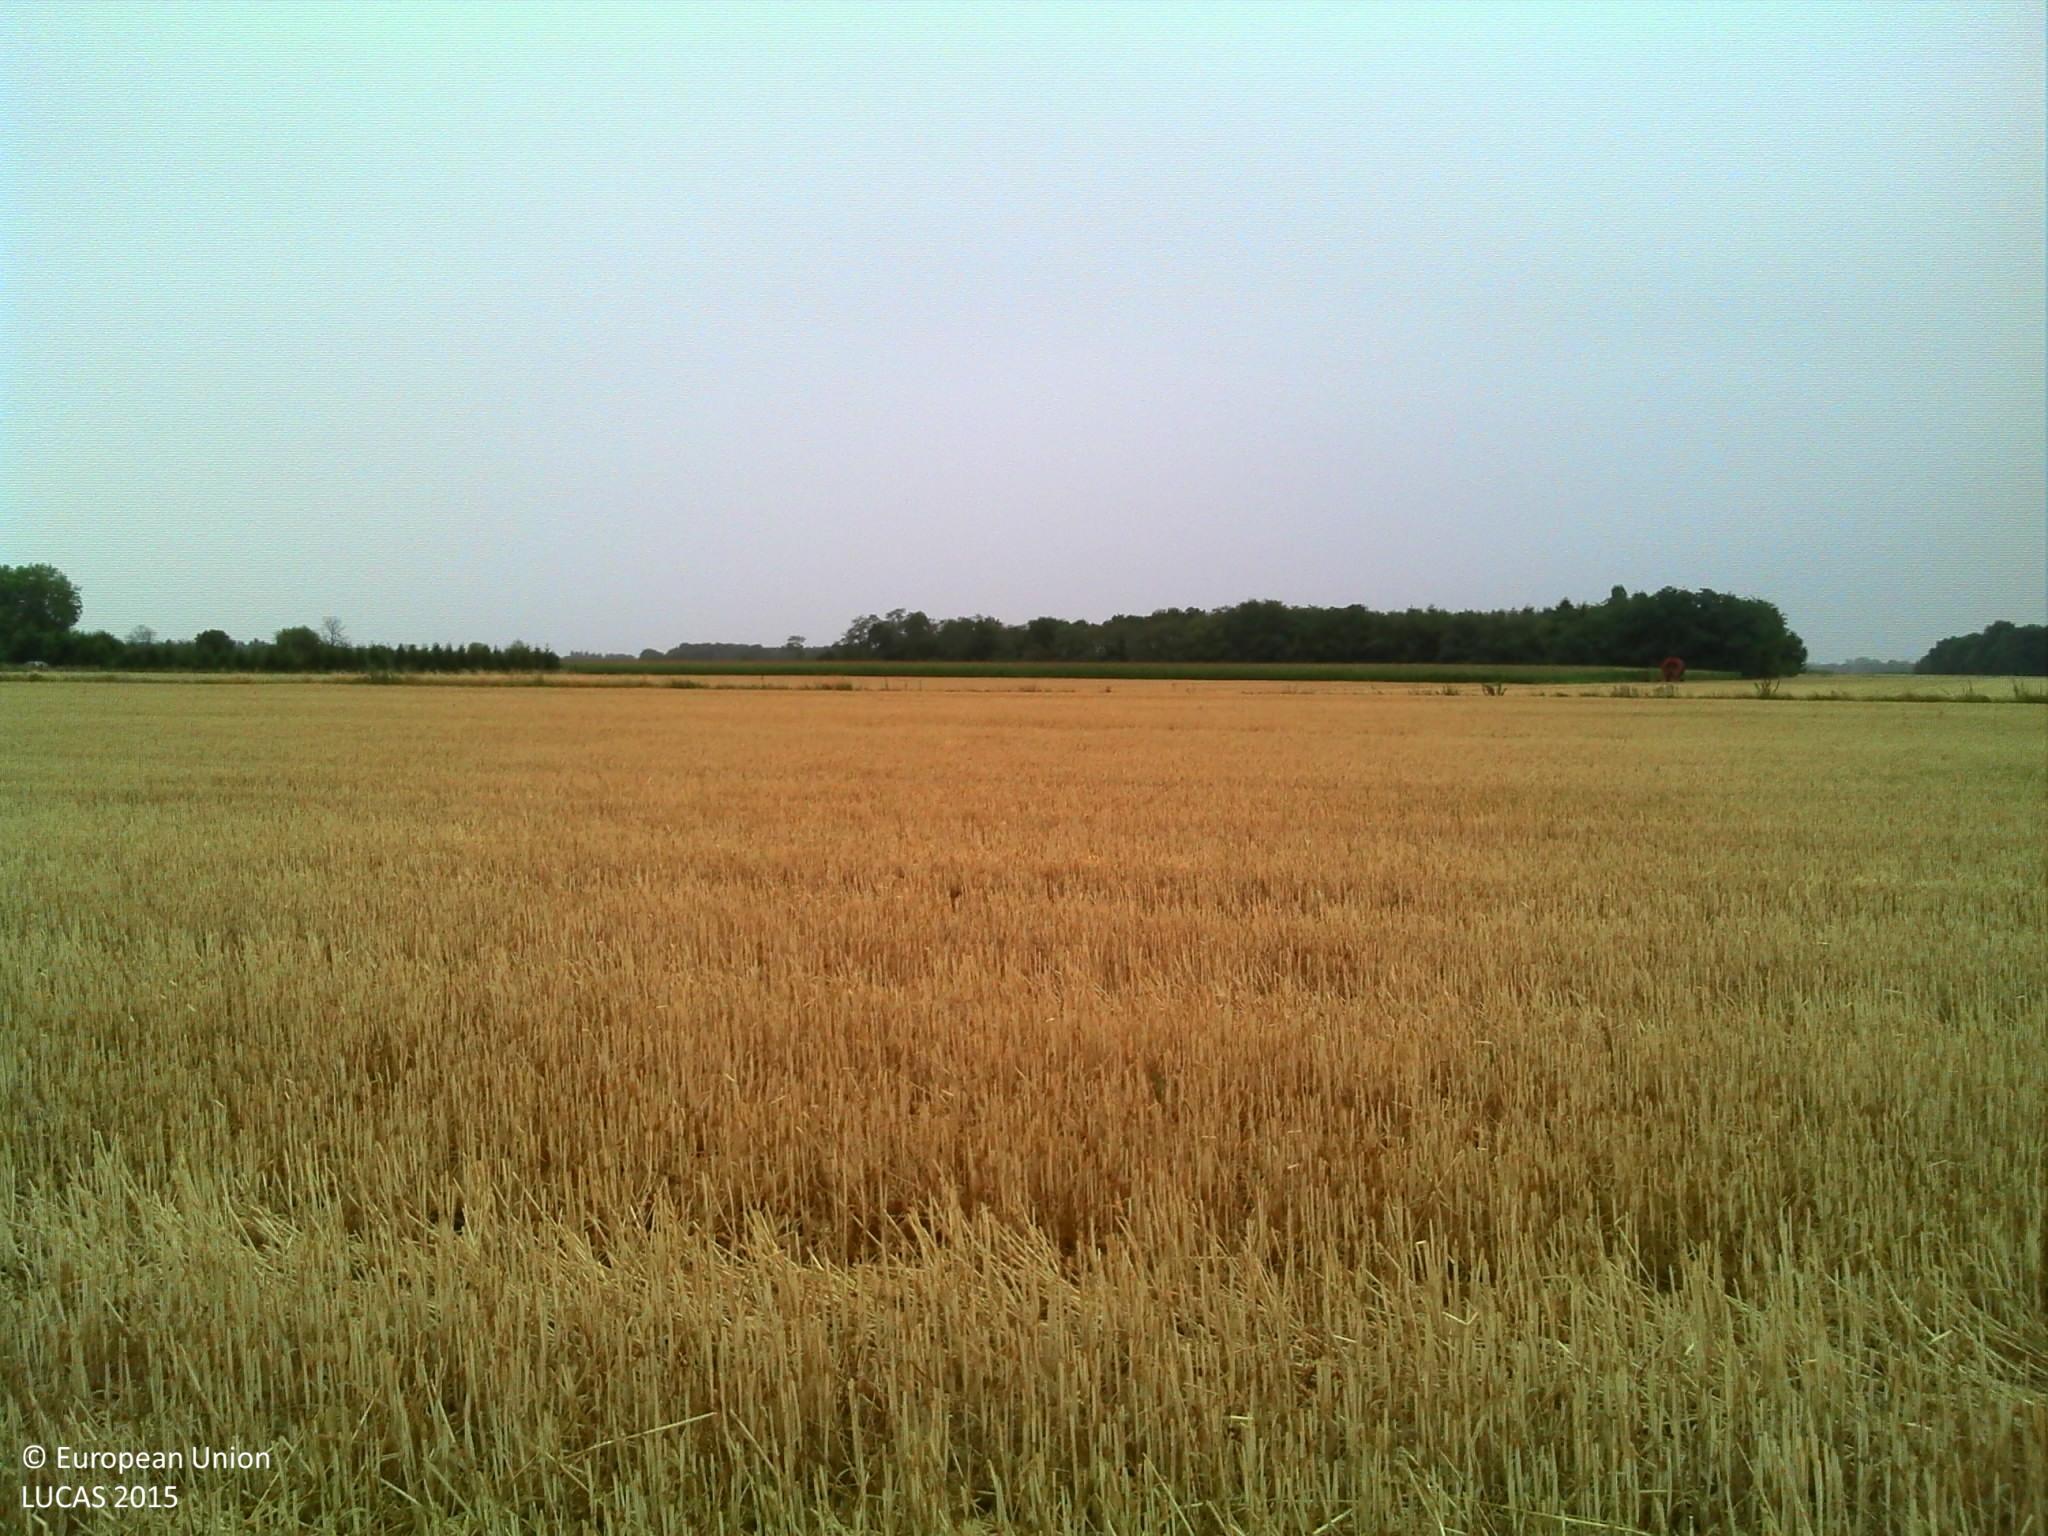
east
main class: Cropland
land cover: Common wheat
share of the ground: > 75 %
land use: Agriculture (excluding fallow land and kitchen gardens)
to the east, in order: Common wheat; Tracks; Triticale; Barley; Maize
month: July
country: FR
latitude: 47.8468
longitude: 2.0642
